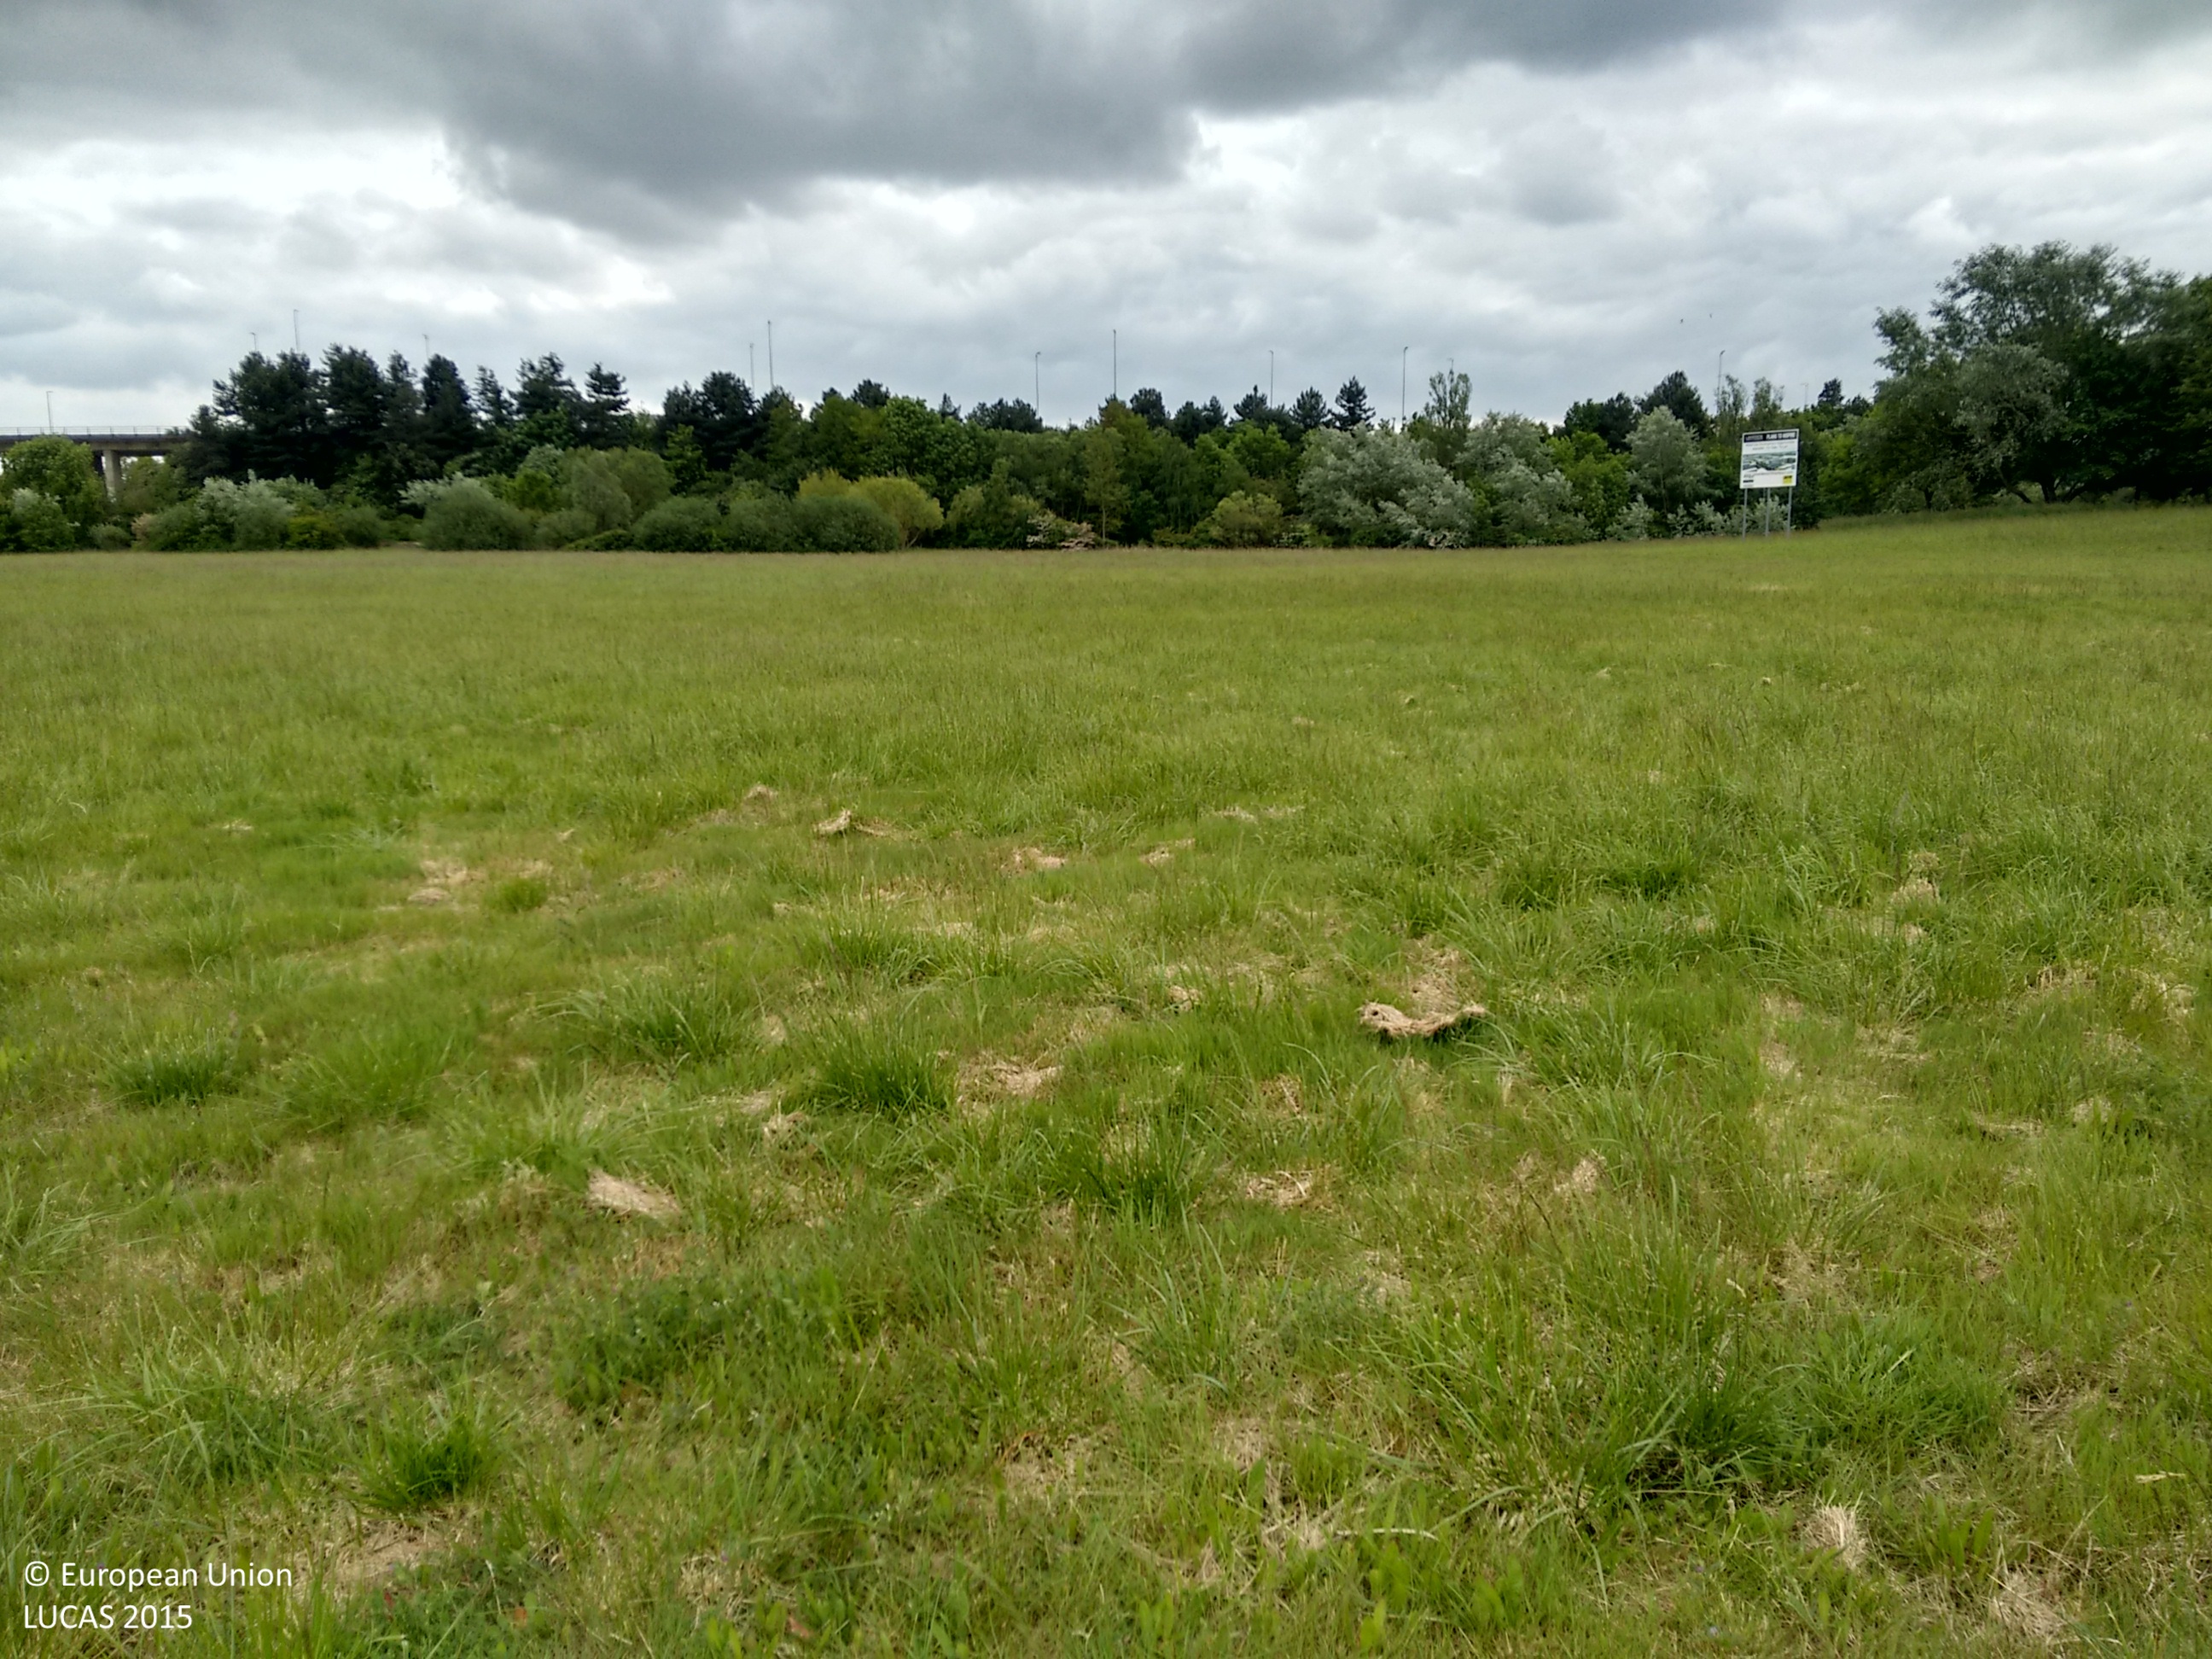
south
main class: Grassland
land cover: Grassland without tree/shrub cover
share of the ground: > 75 %
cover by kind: herbaceous plants 100 %
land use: Semi-natural and natural areas not in use
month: May
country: GB
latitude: 50.8405
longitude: -1.0795
